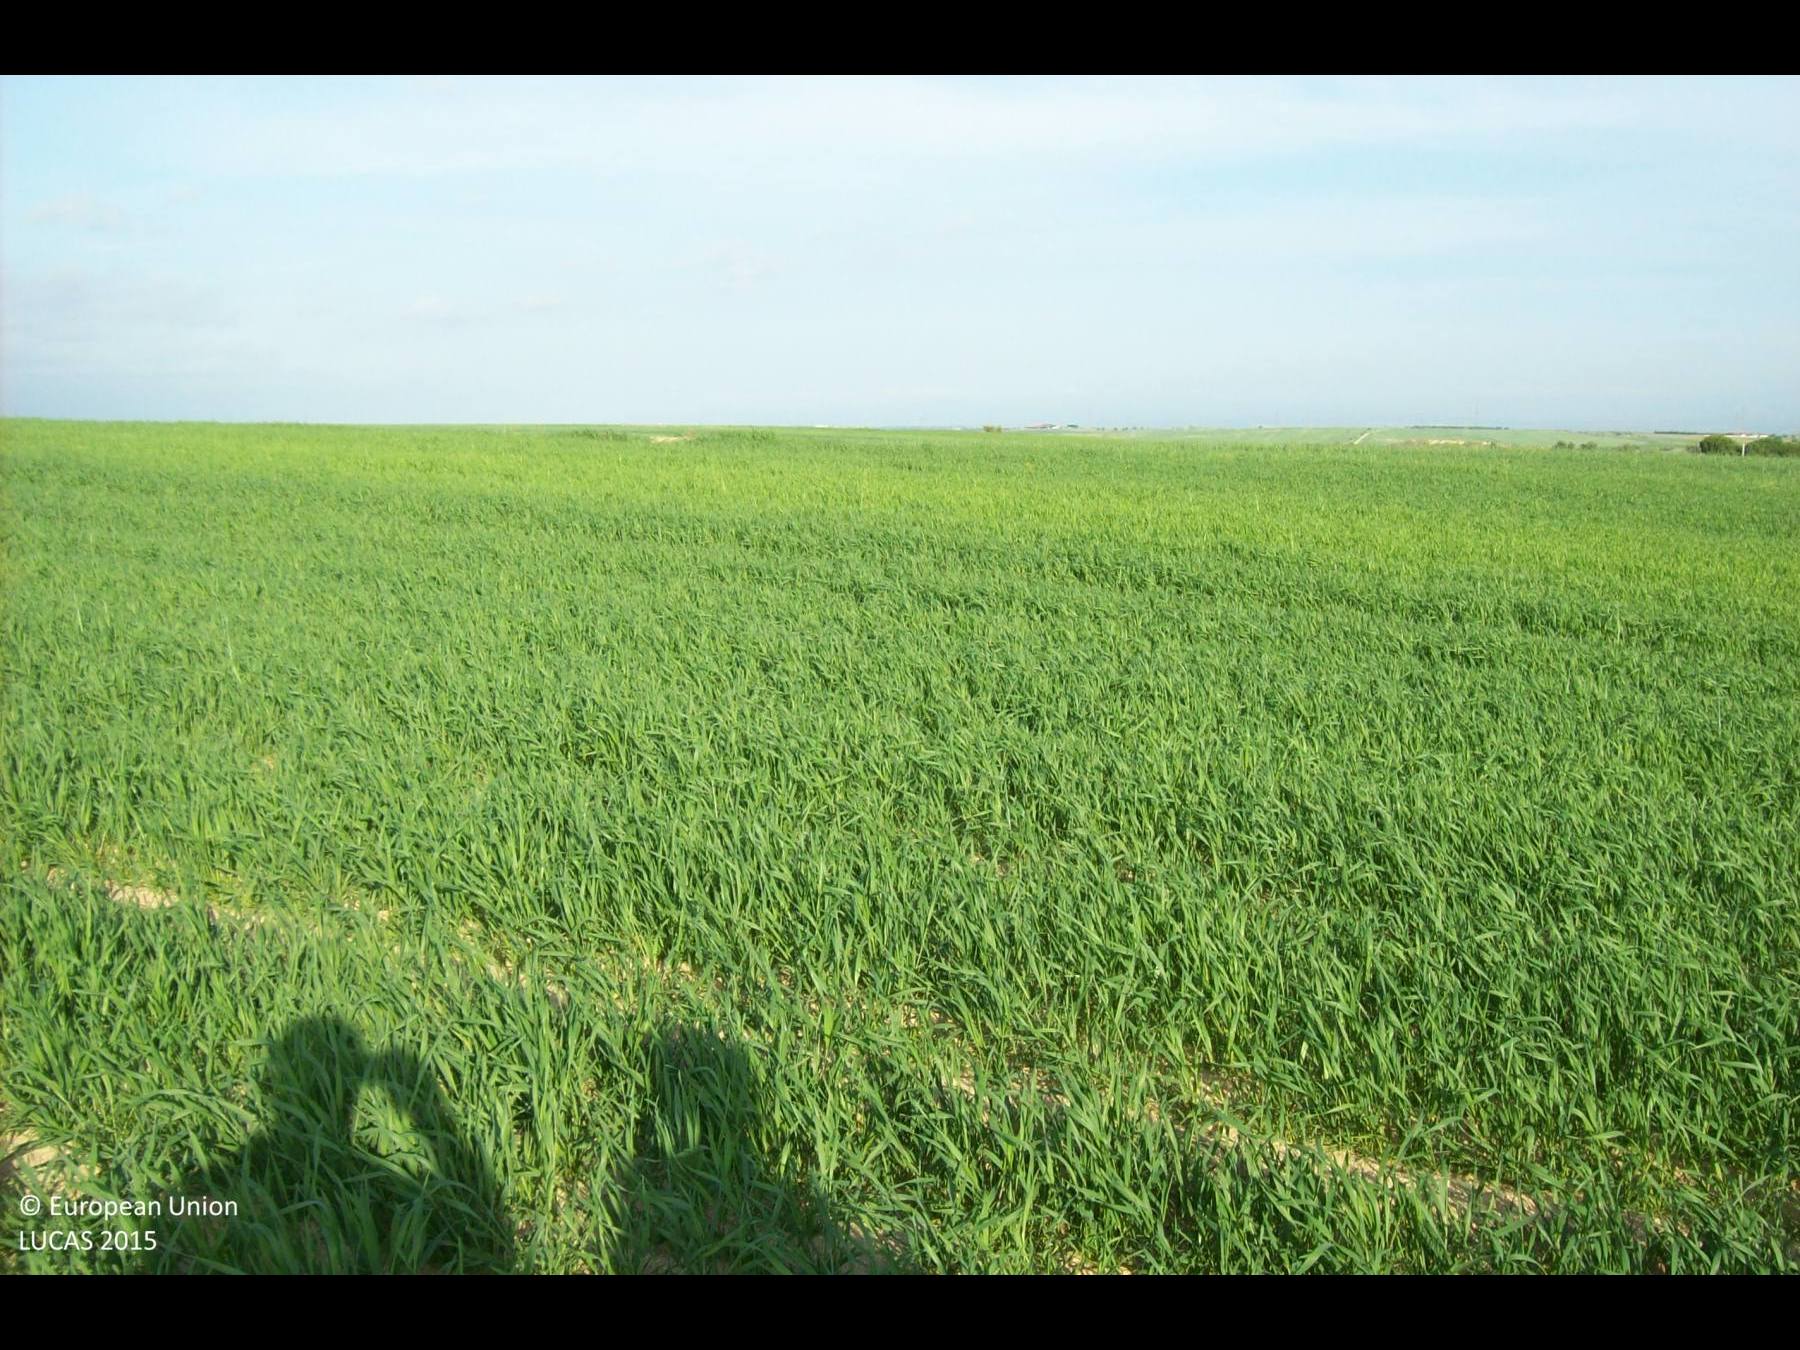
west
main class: Cropland
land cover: Barley
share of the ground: > 75 %
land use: Agriculture (excluding fallow land and kitchen gardens)
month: April
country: ES
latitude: 40.3186
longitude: -3.8899
